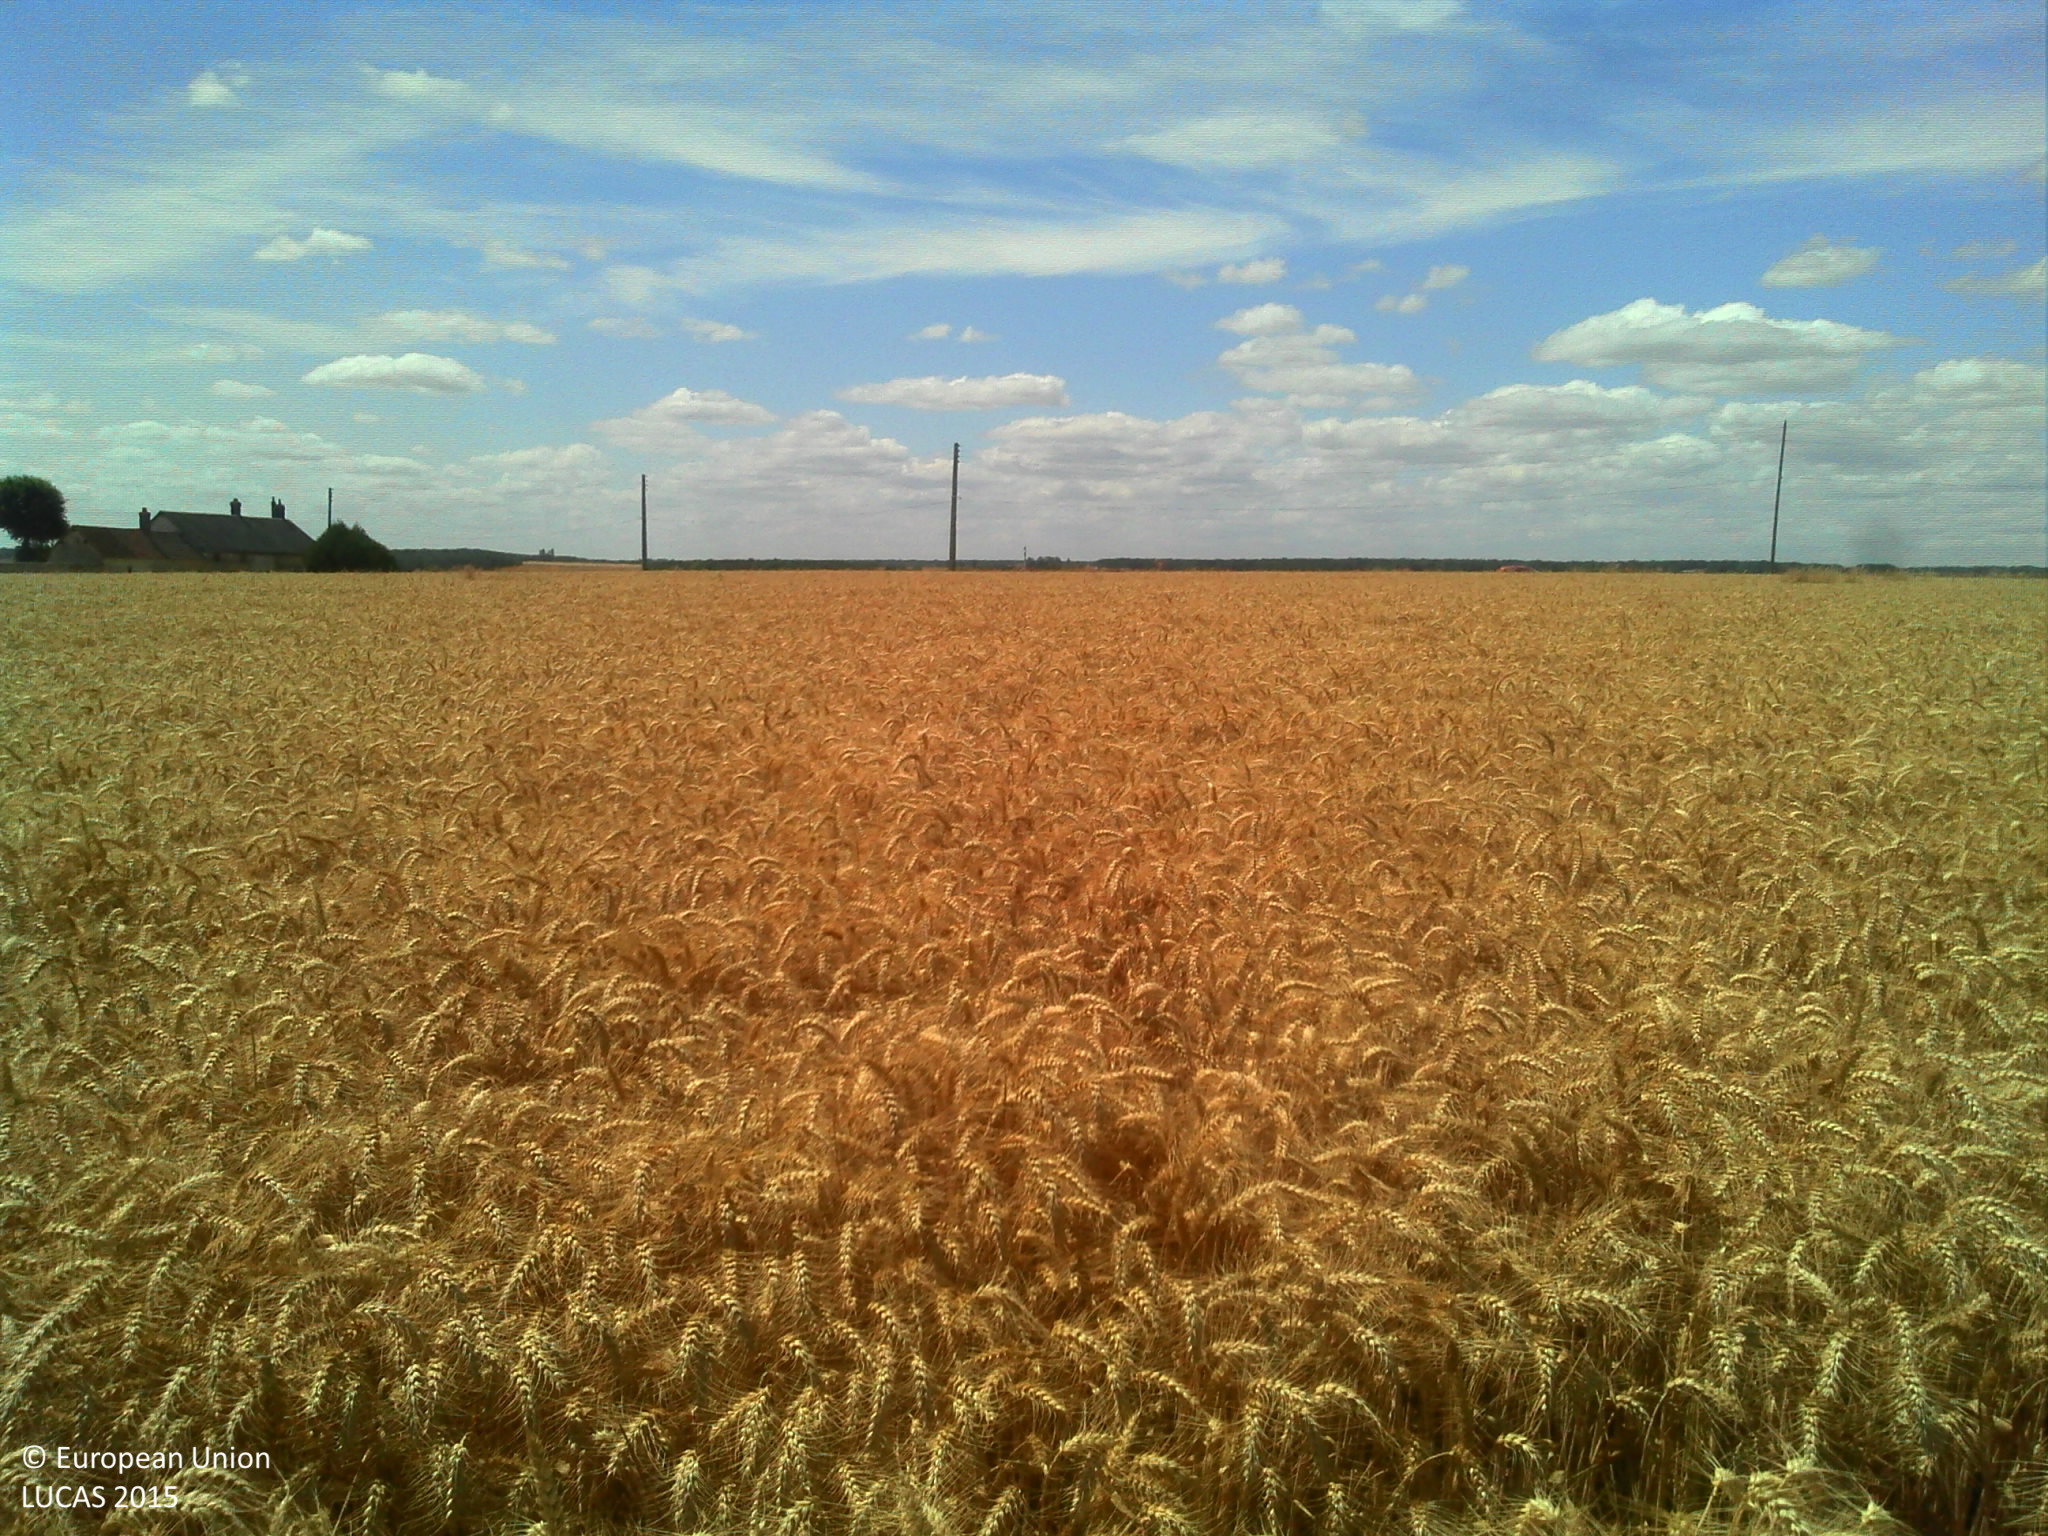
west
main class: Cropland
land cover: Common wheat
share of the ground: > 75 %
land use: Agriculture (excluding fallow land and kitchen gardens)
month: July
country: FR
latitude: 48.3636
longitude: 1.2488
